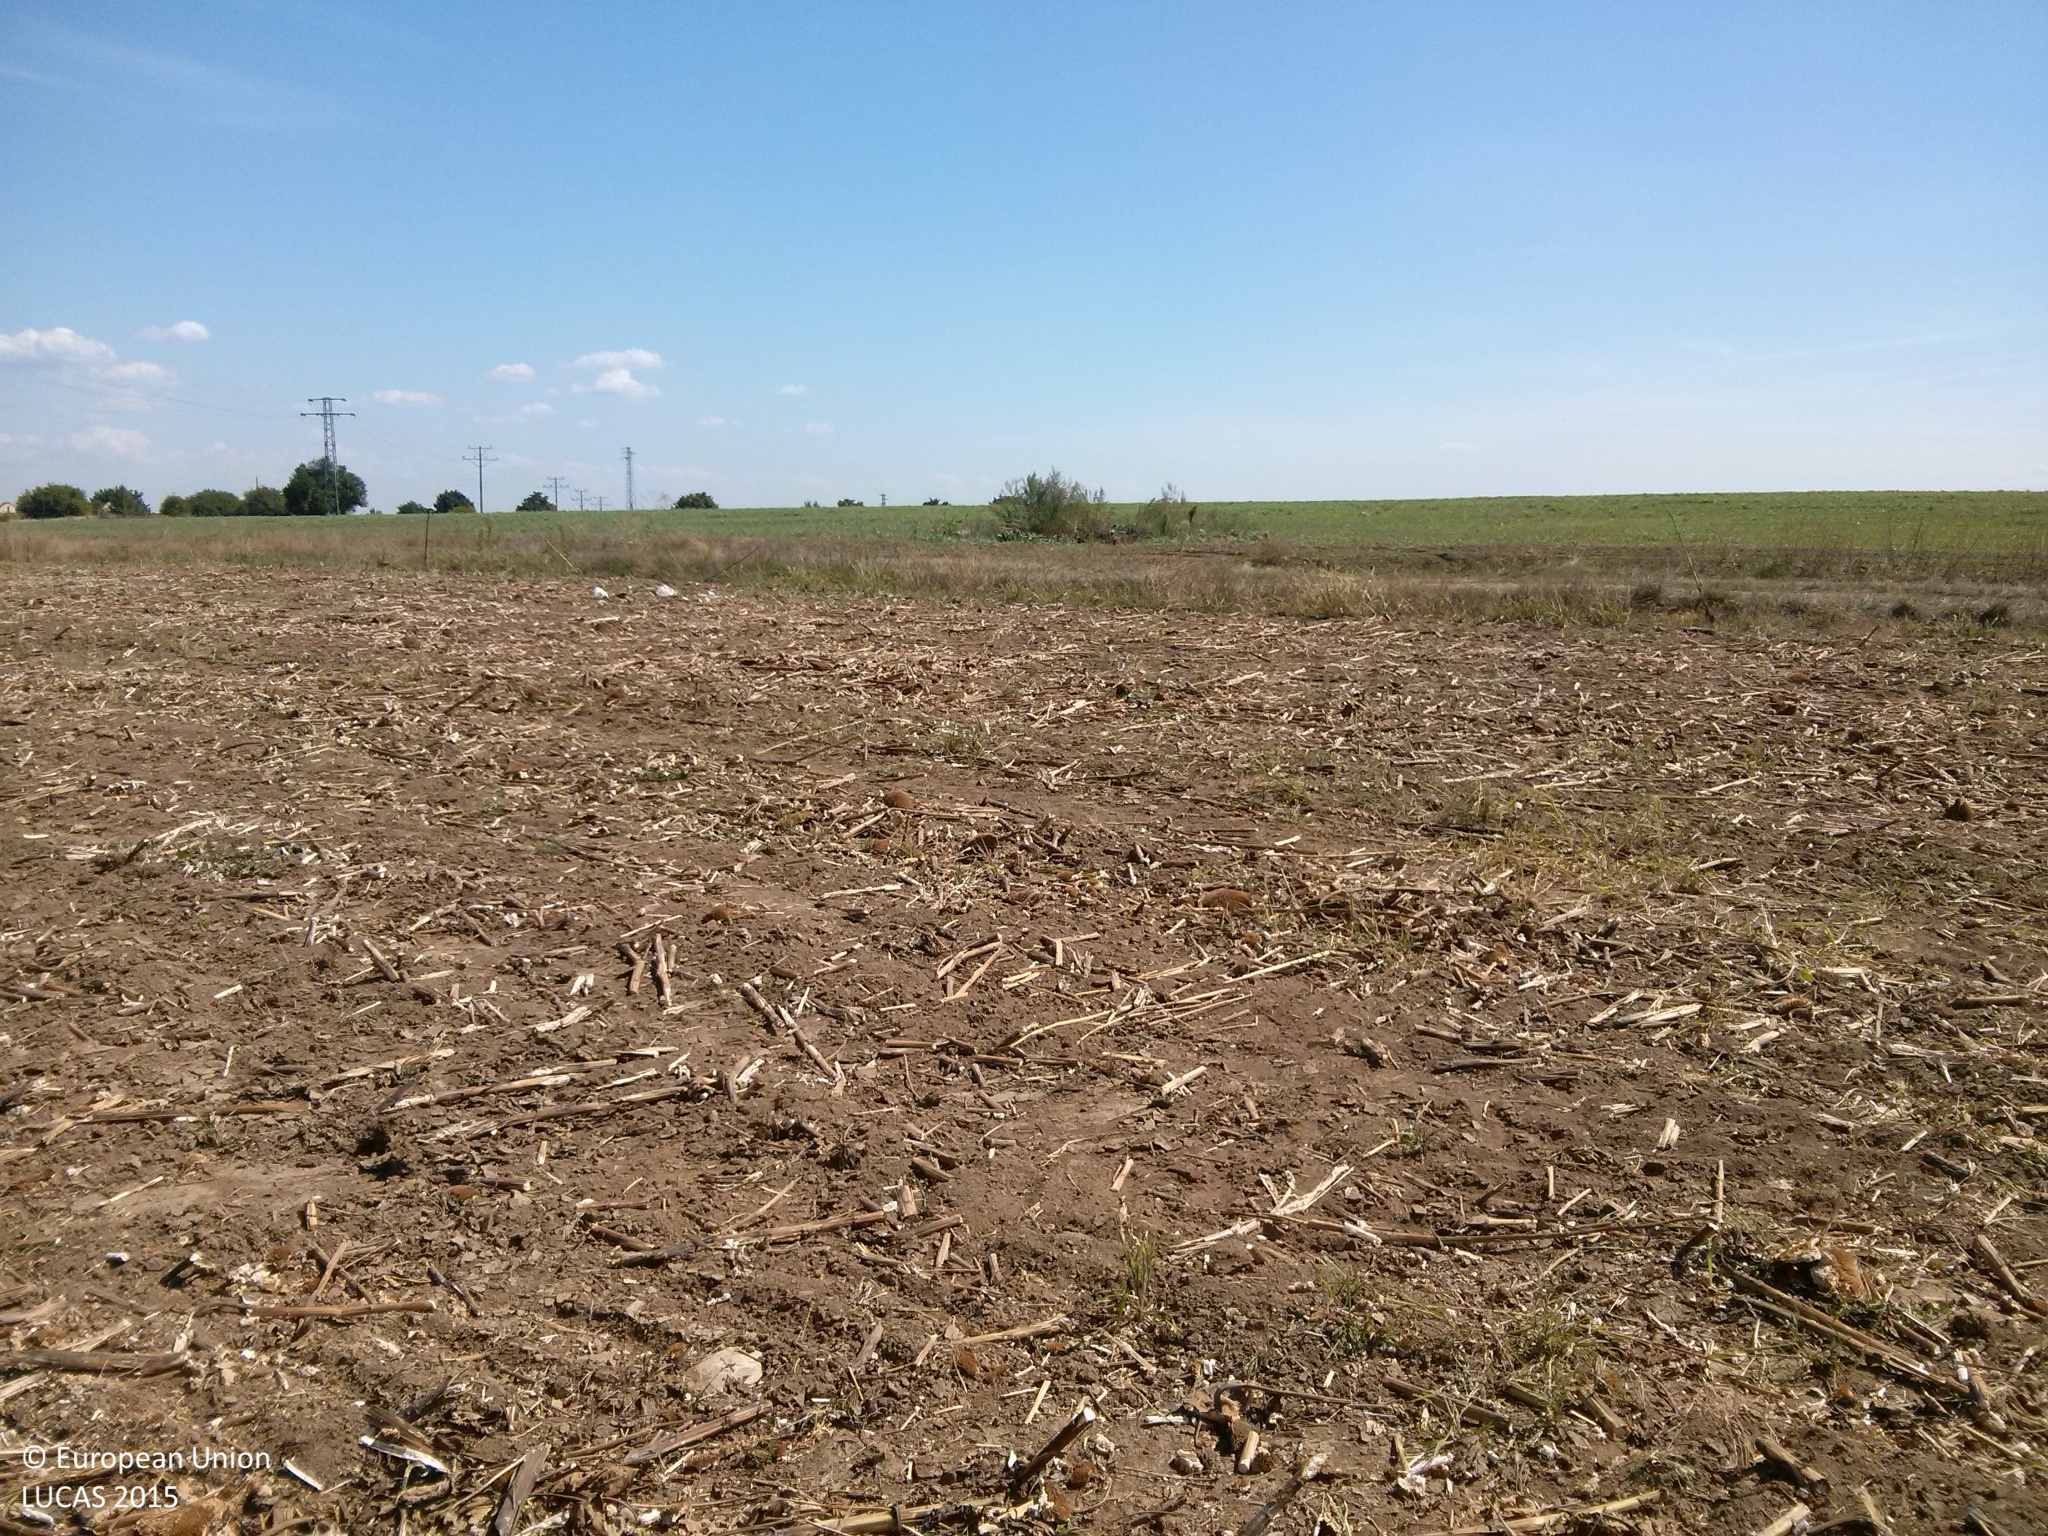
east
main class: Cropland
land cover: Sunflower
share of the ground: < 10 %
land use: Agriculture (excluding fallow land and kitchen gardens)
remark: Harvested field
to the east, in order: Sunflower; Grass margins; Tracks; Grass margins; Lucerne
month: September
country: BG
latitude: 43.6699
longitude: 26.3372
